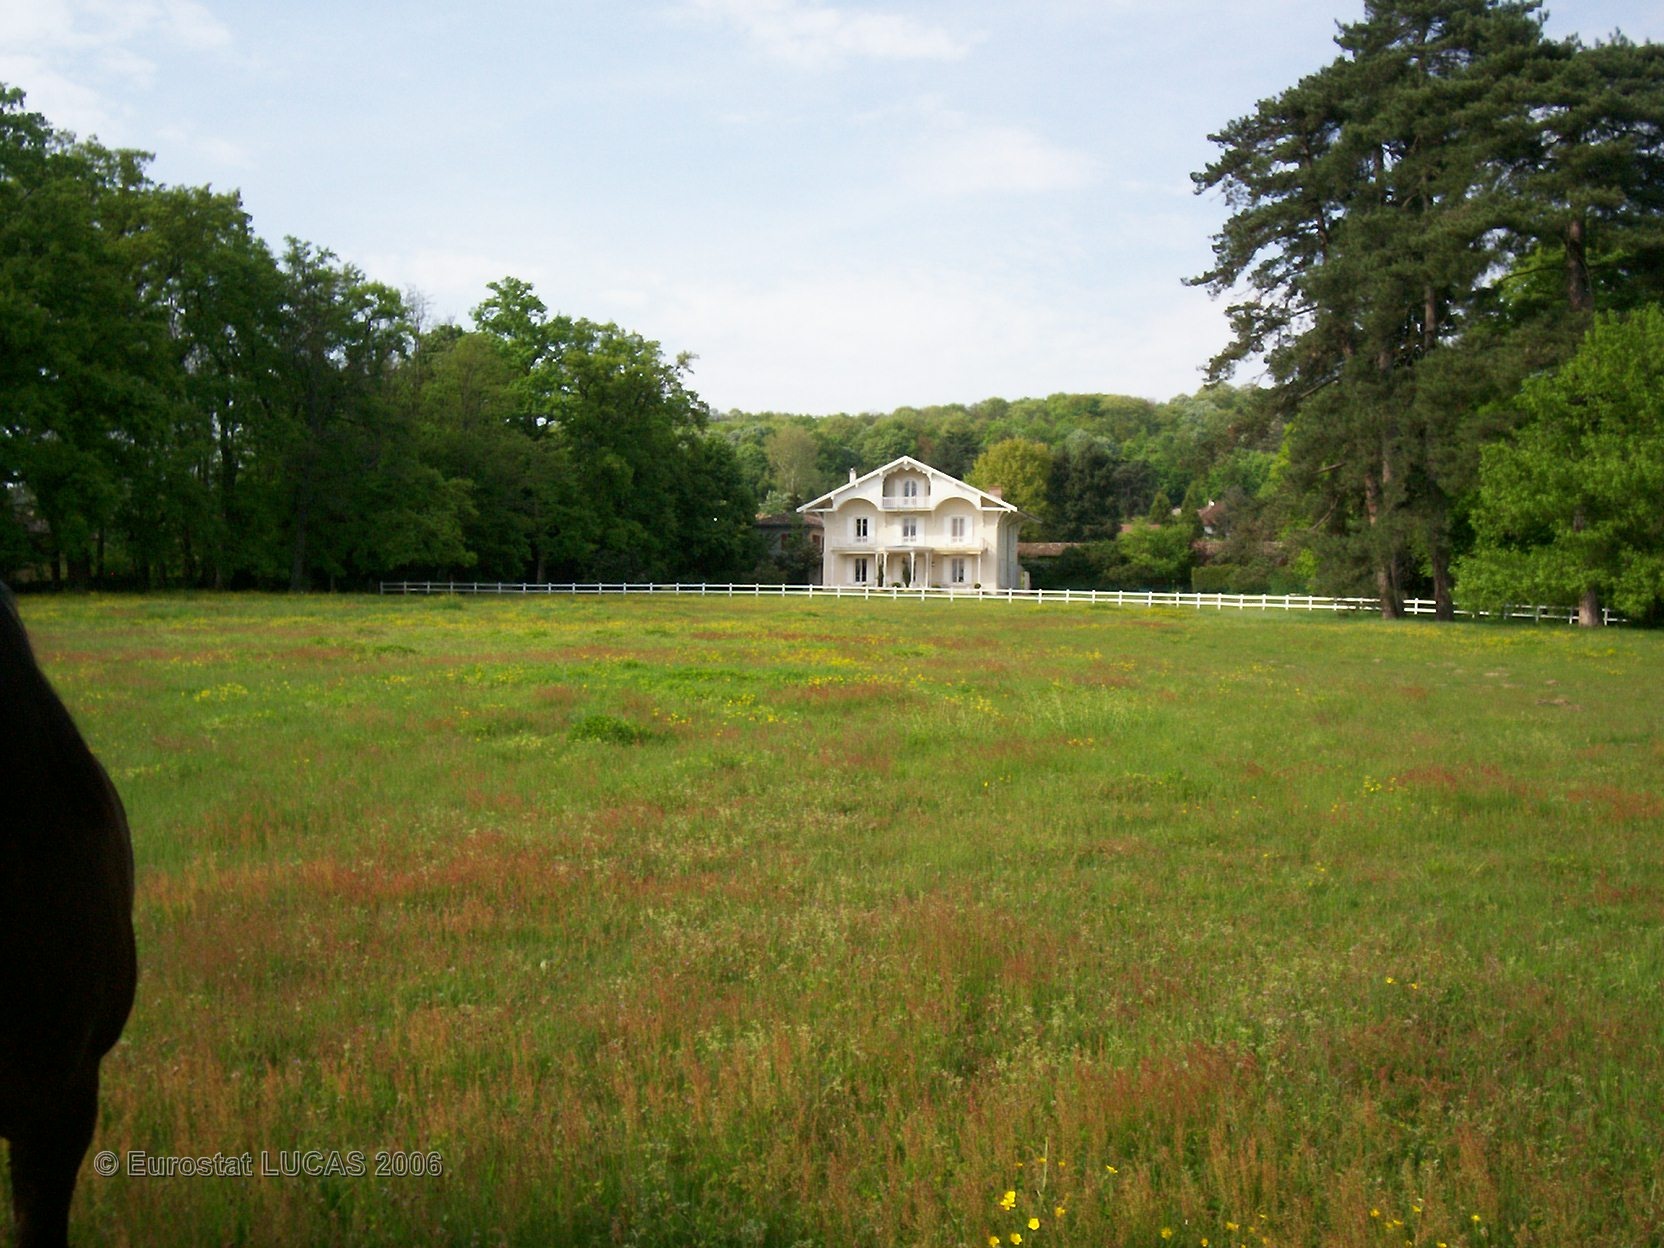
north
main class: Grassland
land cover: Grassland without tree/shrub cover
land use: Agriculture (excluding fallow land and kitchen gardens)
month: May
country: FR
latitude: 45.9362
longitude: 4.8054
